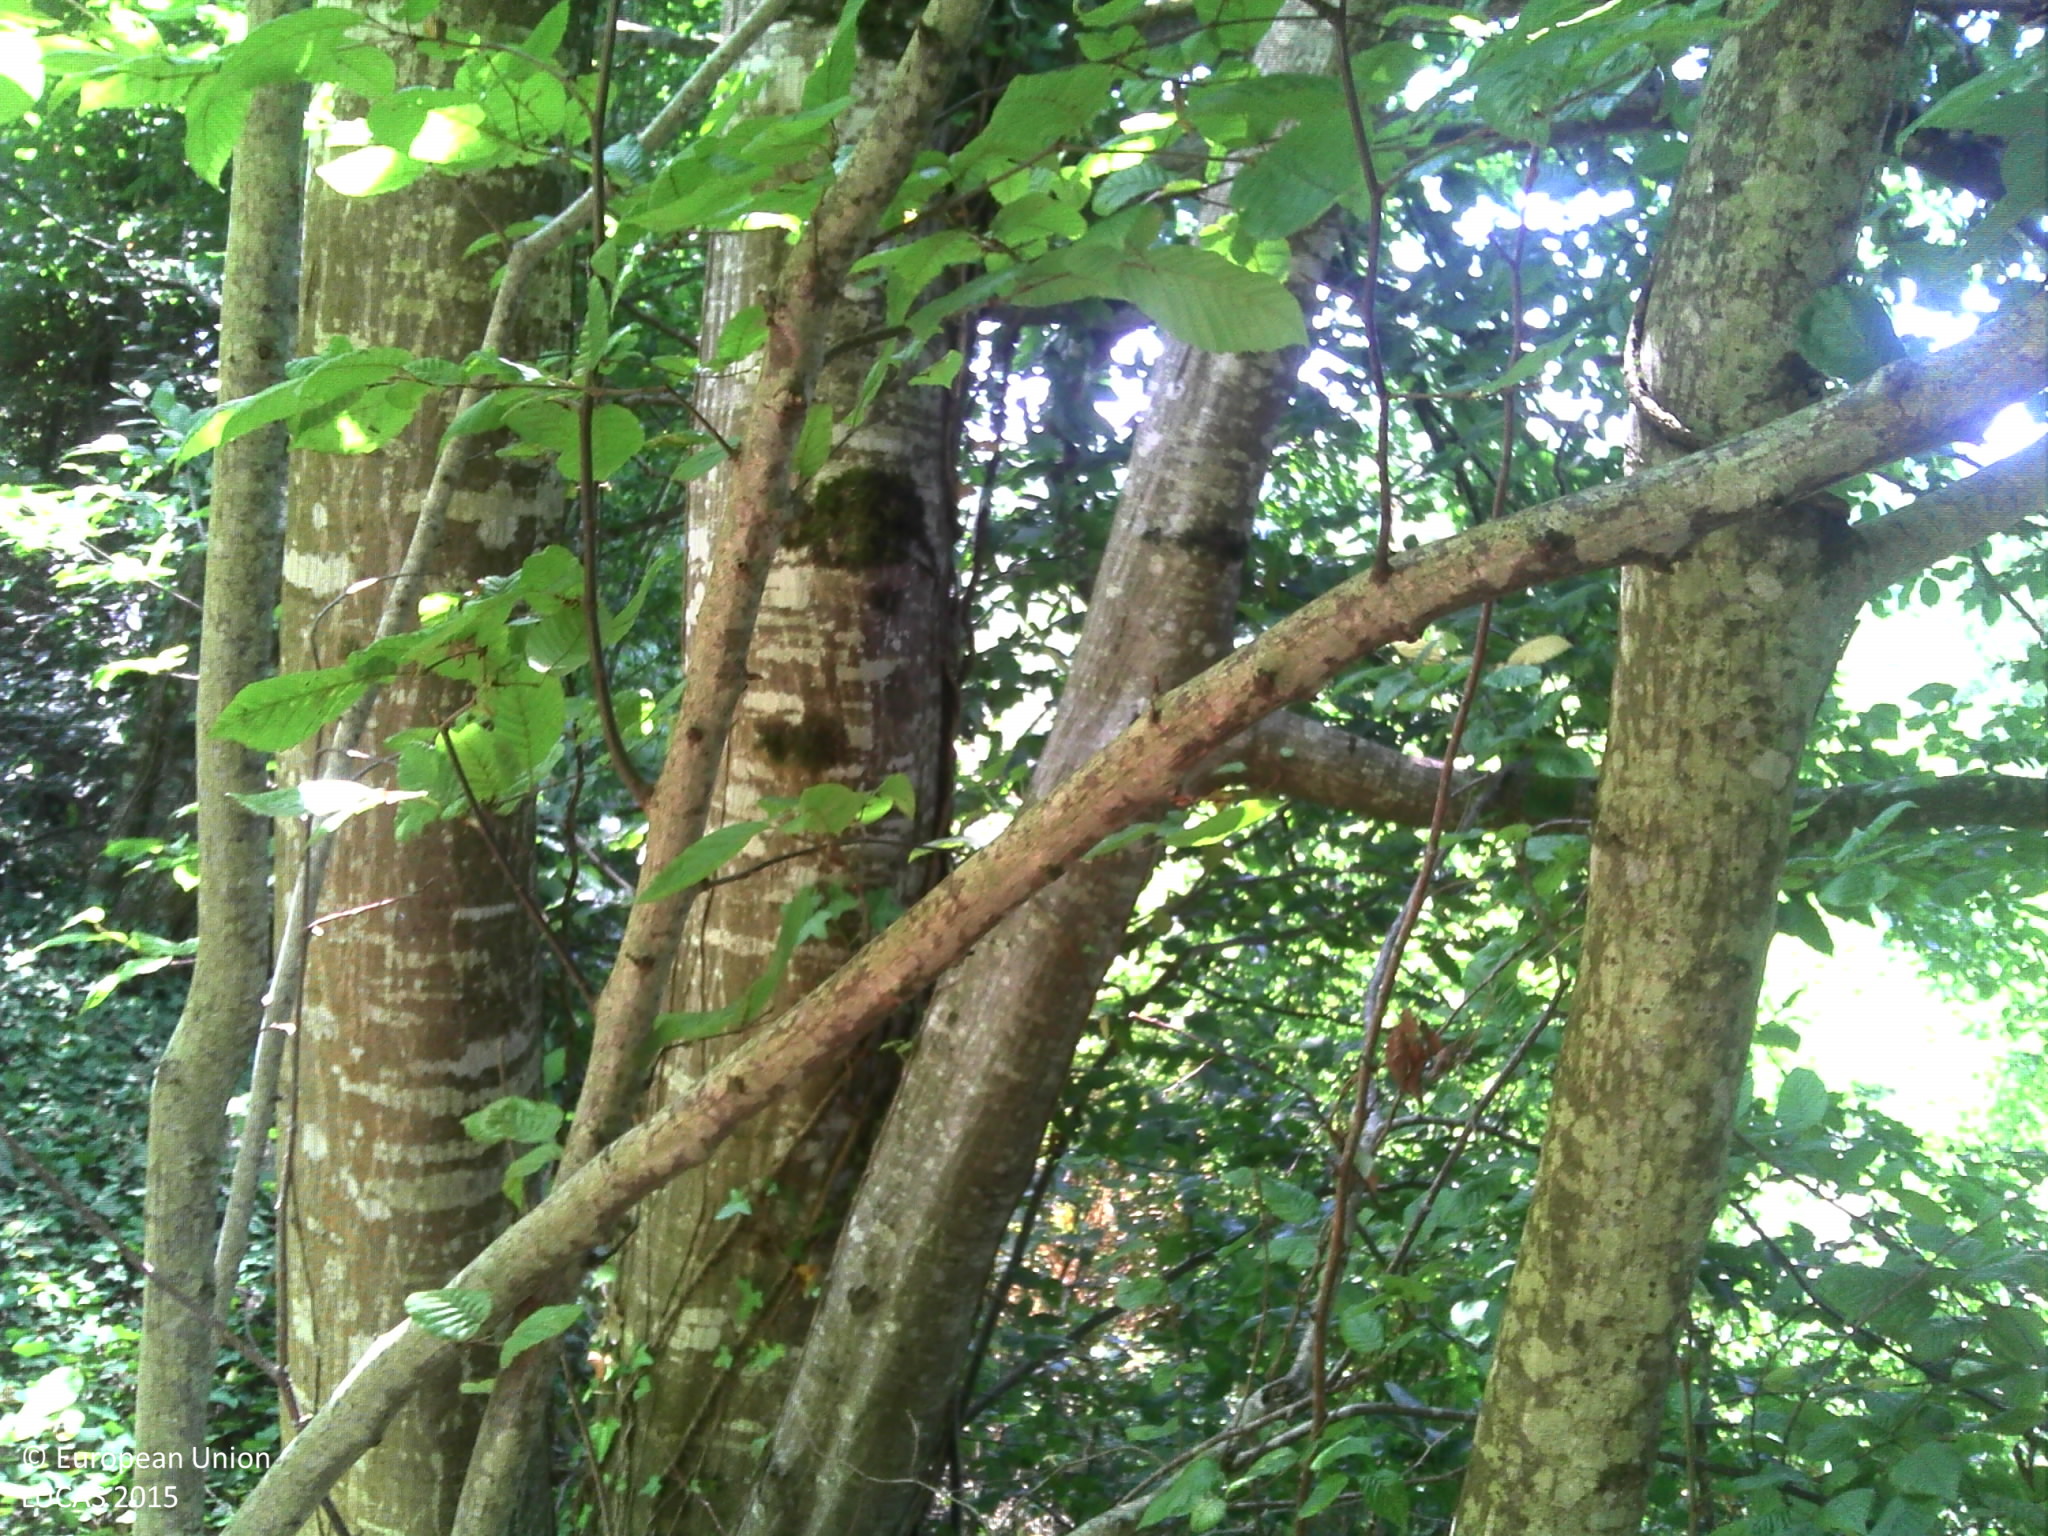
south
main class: Woodland
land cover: Broadleaved woodland
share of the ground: > 75 %
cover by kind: broadleaved forest trees 75 %, herbaceous plants 20 %, coniferous forest trees 5 %
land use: Residential
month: August
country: FR
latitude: 45.2378
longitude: 1.7798
